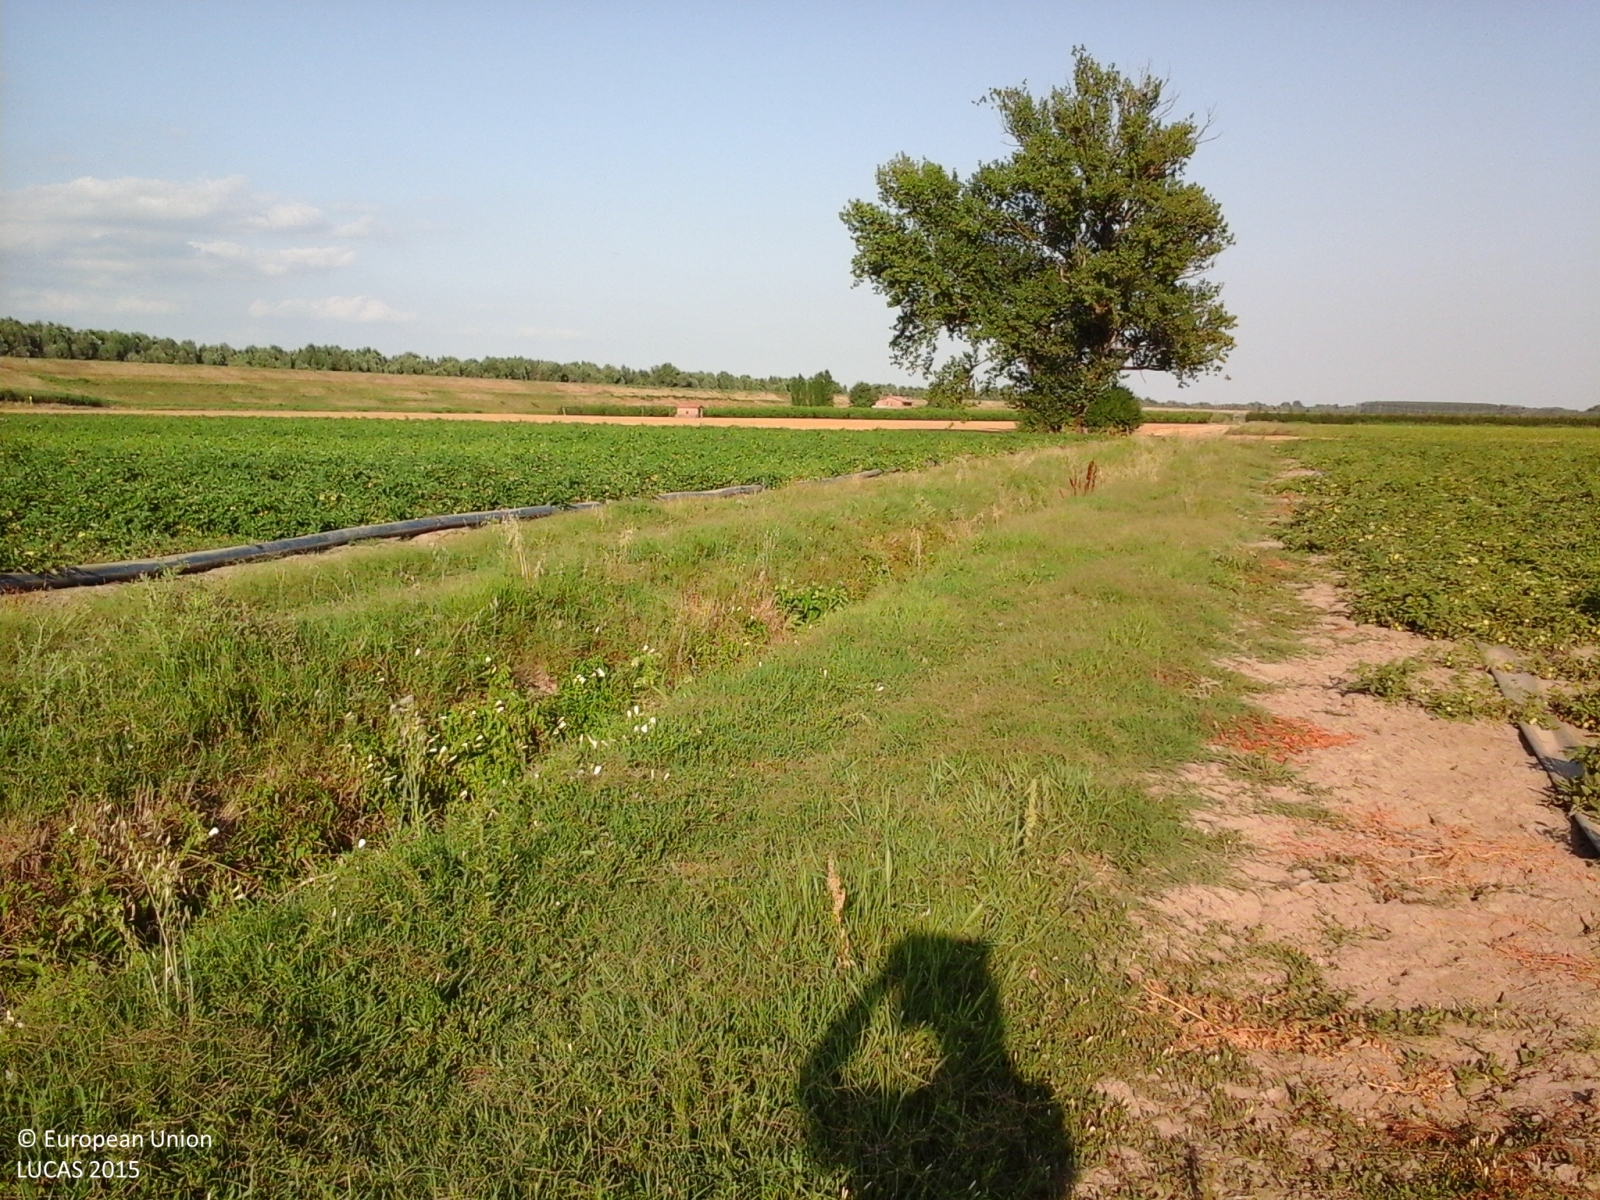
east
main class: Cropland
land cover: Tomatoes
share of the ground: > 75 %
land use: Agriculture (excluding fallow land and kitchen gardens)
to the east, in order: Tomatoes; Ditches and canals; Tomatoes; Ditches and canals; Tomatoes; Ditches and canals; Common wheat; Ditches and canals; Sugar beet
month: July
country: IT
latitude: 44.7178
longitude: 11.5496
